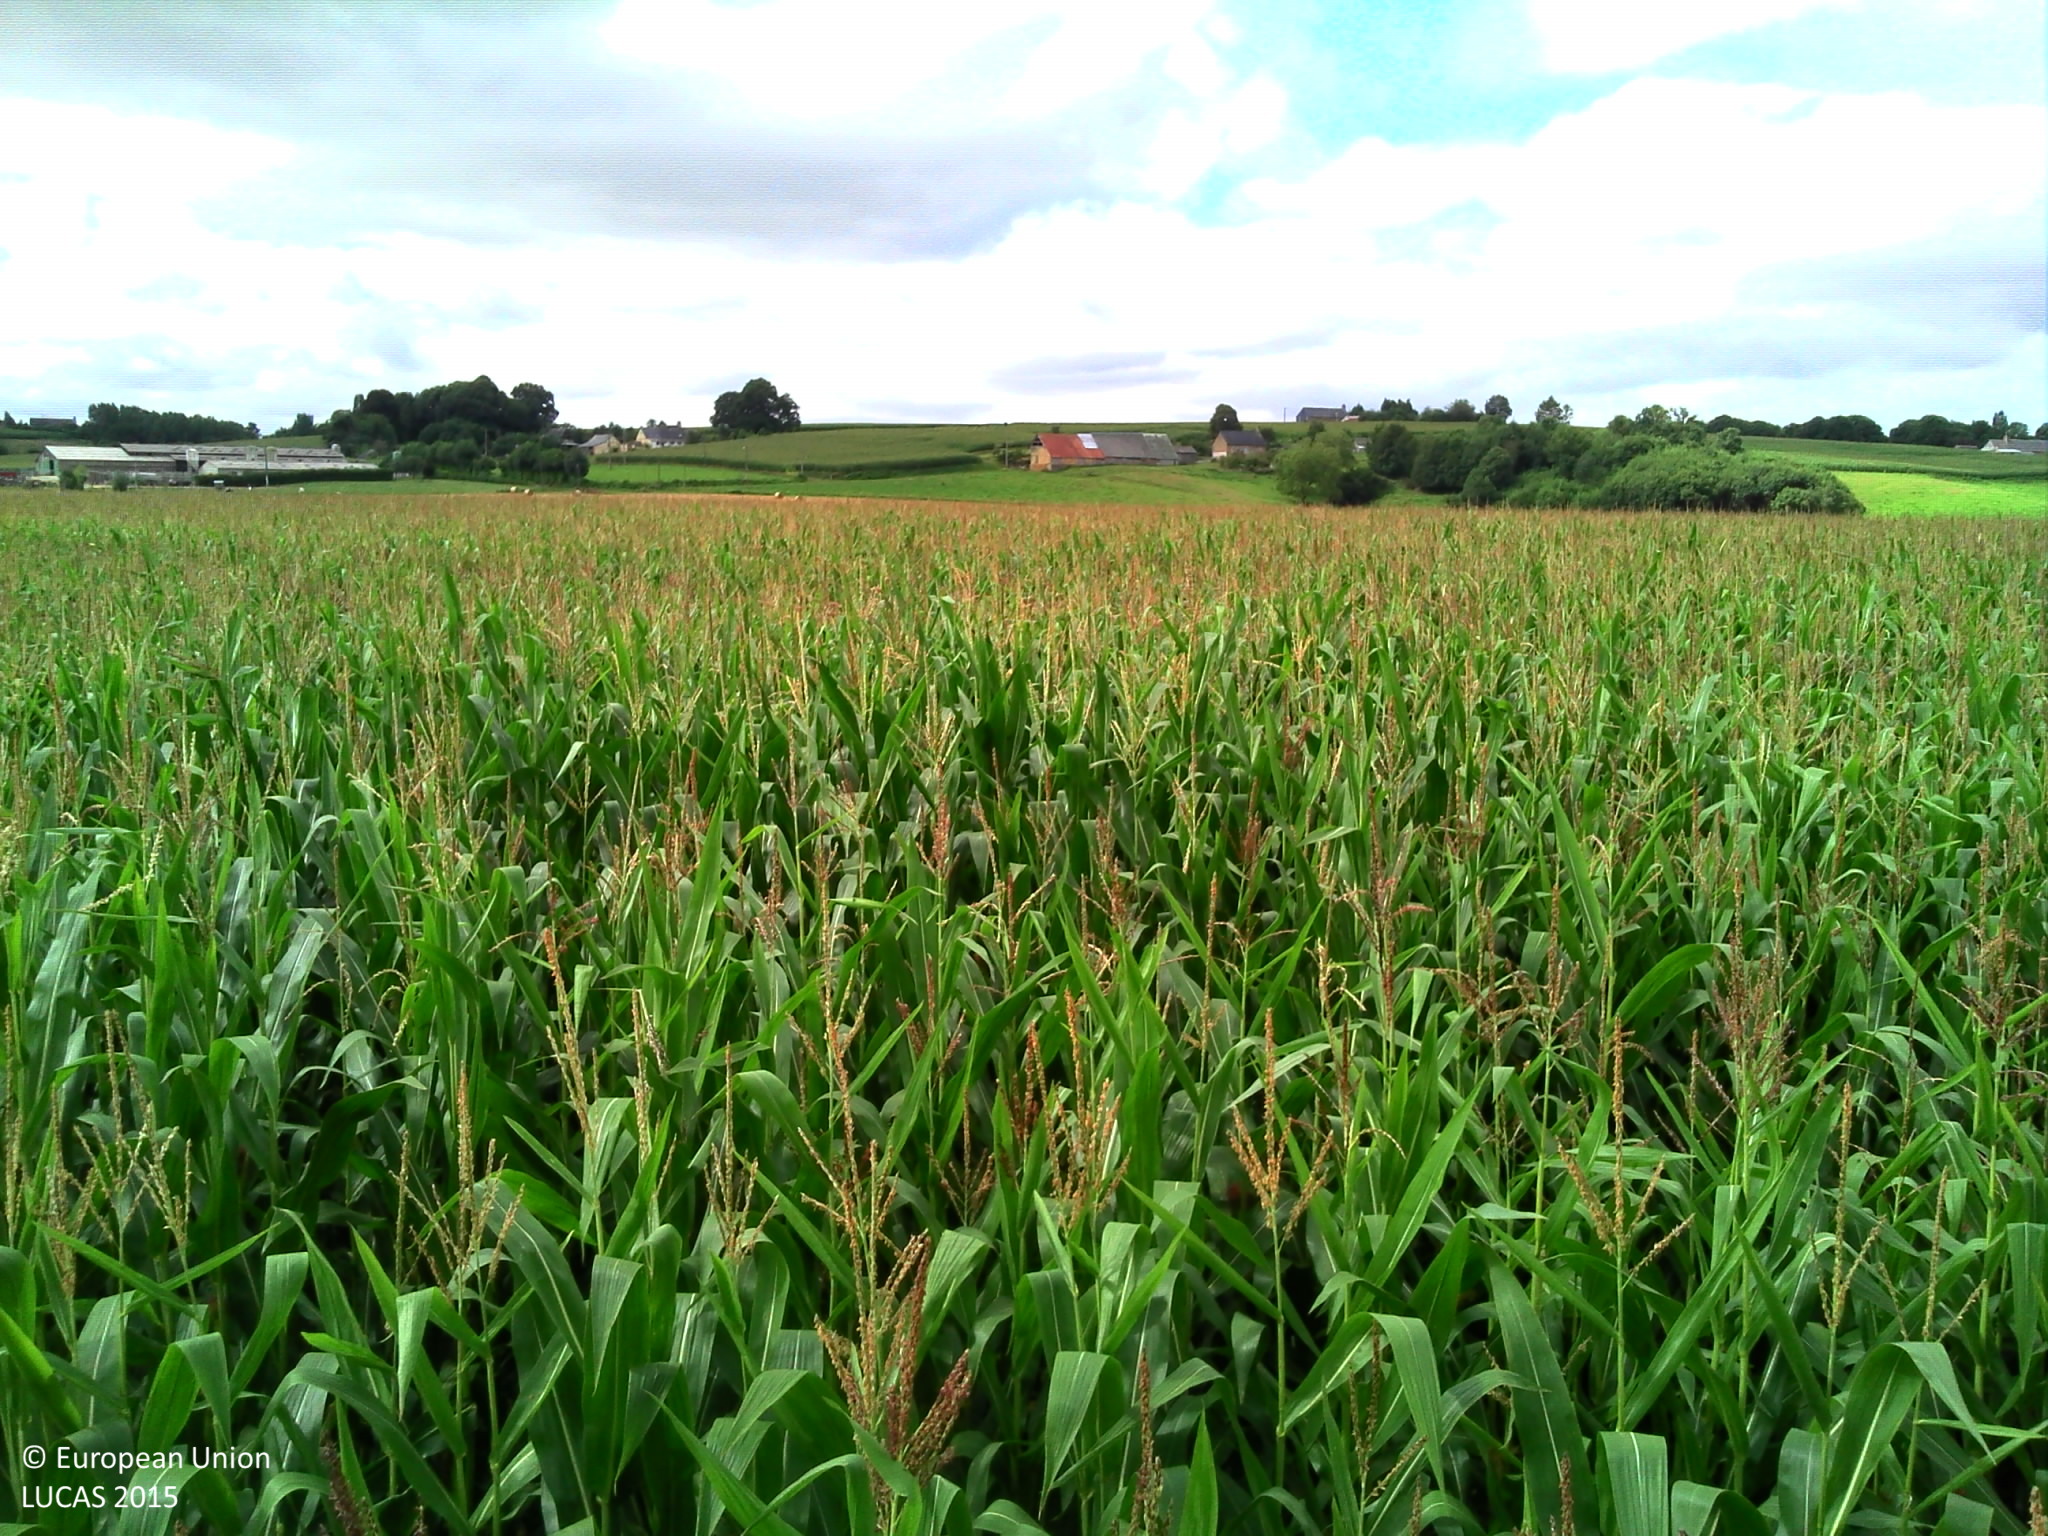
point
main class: Cropland
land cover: Maize
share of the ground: > 75 %
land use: Agriculture (excluding fallow land and kitchen gardens)
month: August
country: FR
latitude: 48.5569
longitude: -1.2214
